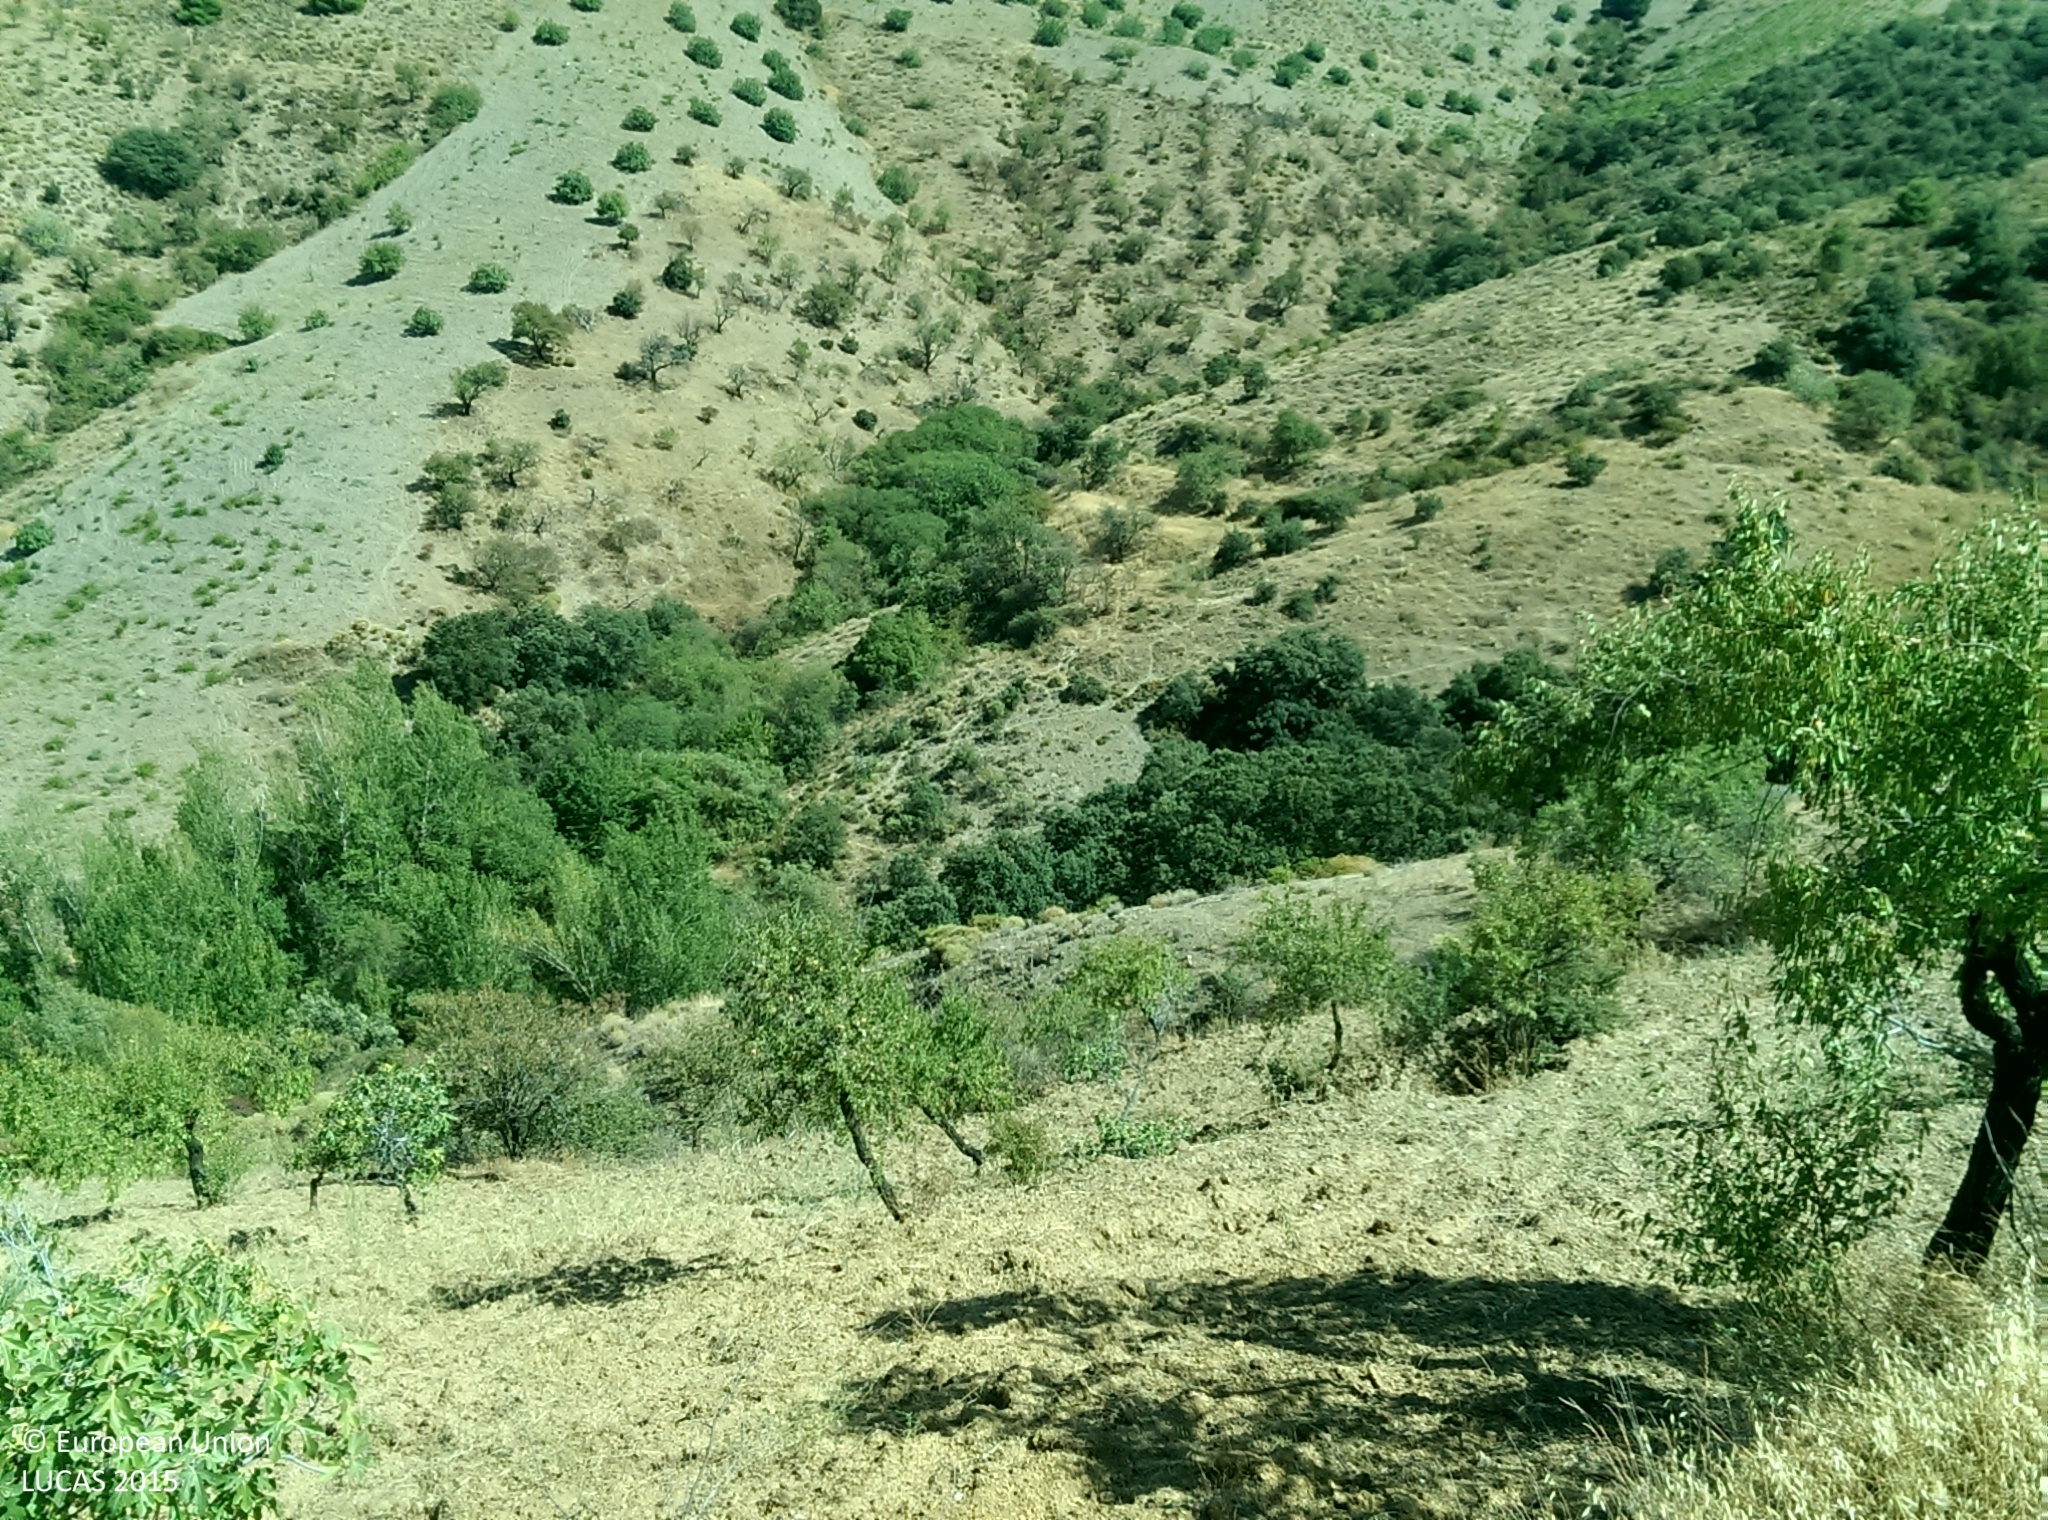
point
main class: Woodland
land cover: Broadleaved woodland
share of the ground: 25 - 50 %
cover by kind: broadleaved forest trees 40 %, herbaceous plants 30 %, shrubs 20 %, unconsolidated bare surface 10 %
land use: Semi-natural and natural areas not in use
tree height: > 5 m
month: August
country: ES
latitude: 36.8948
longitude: -3.2115
